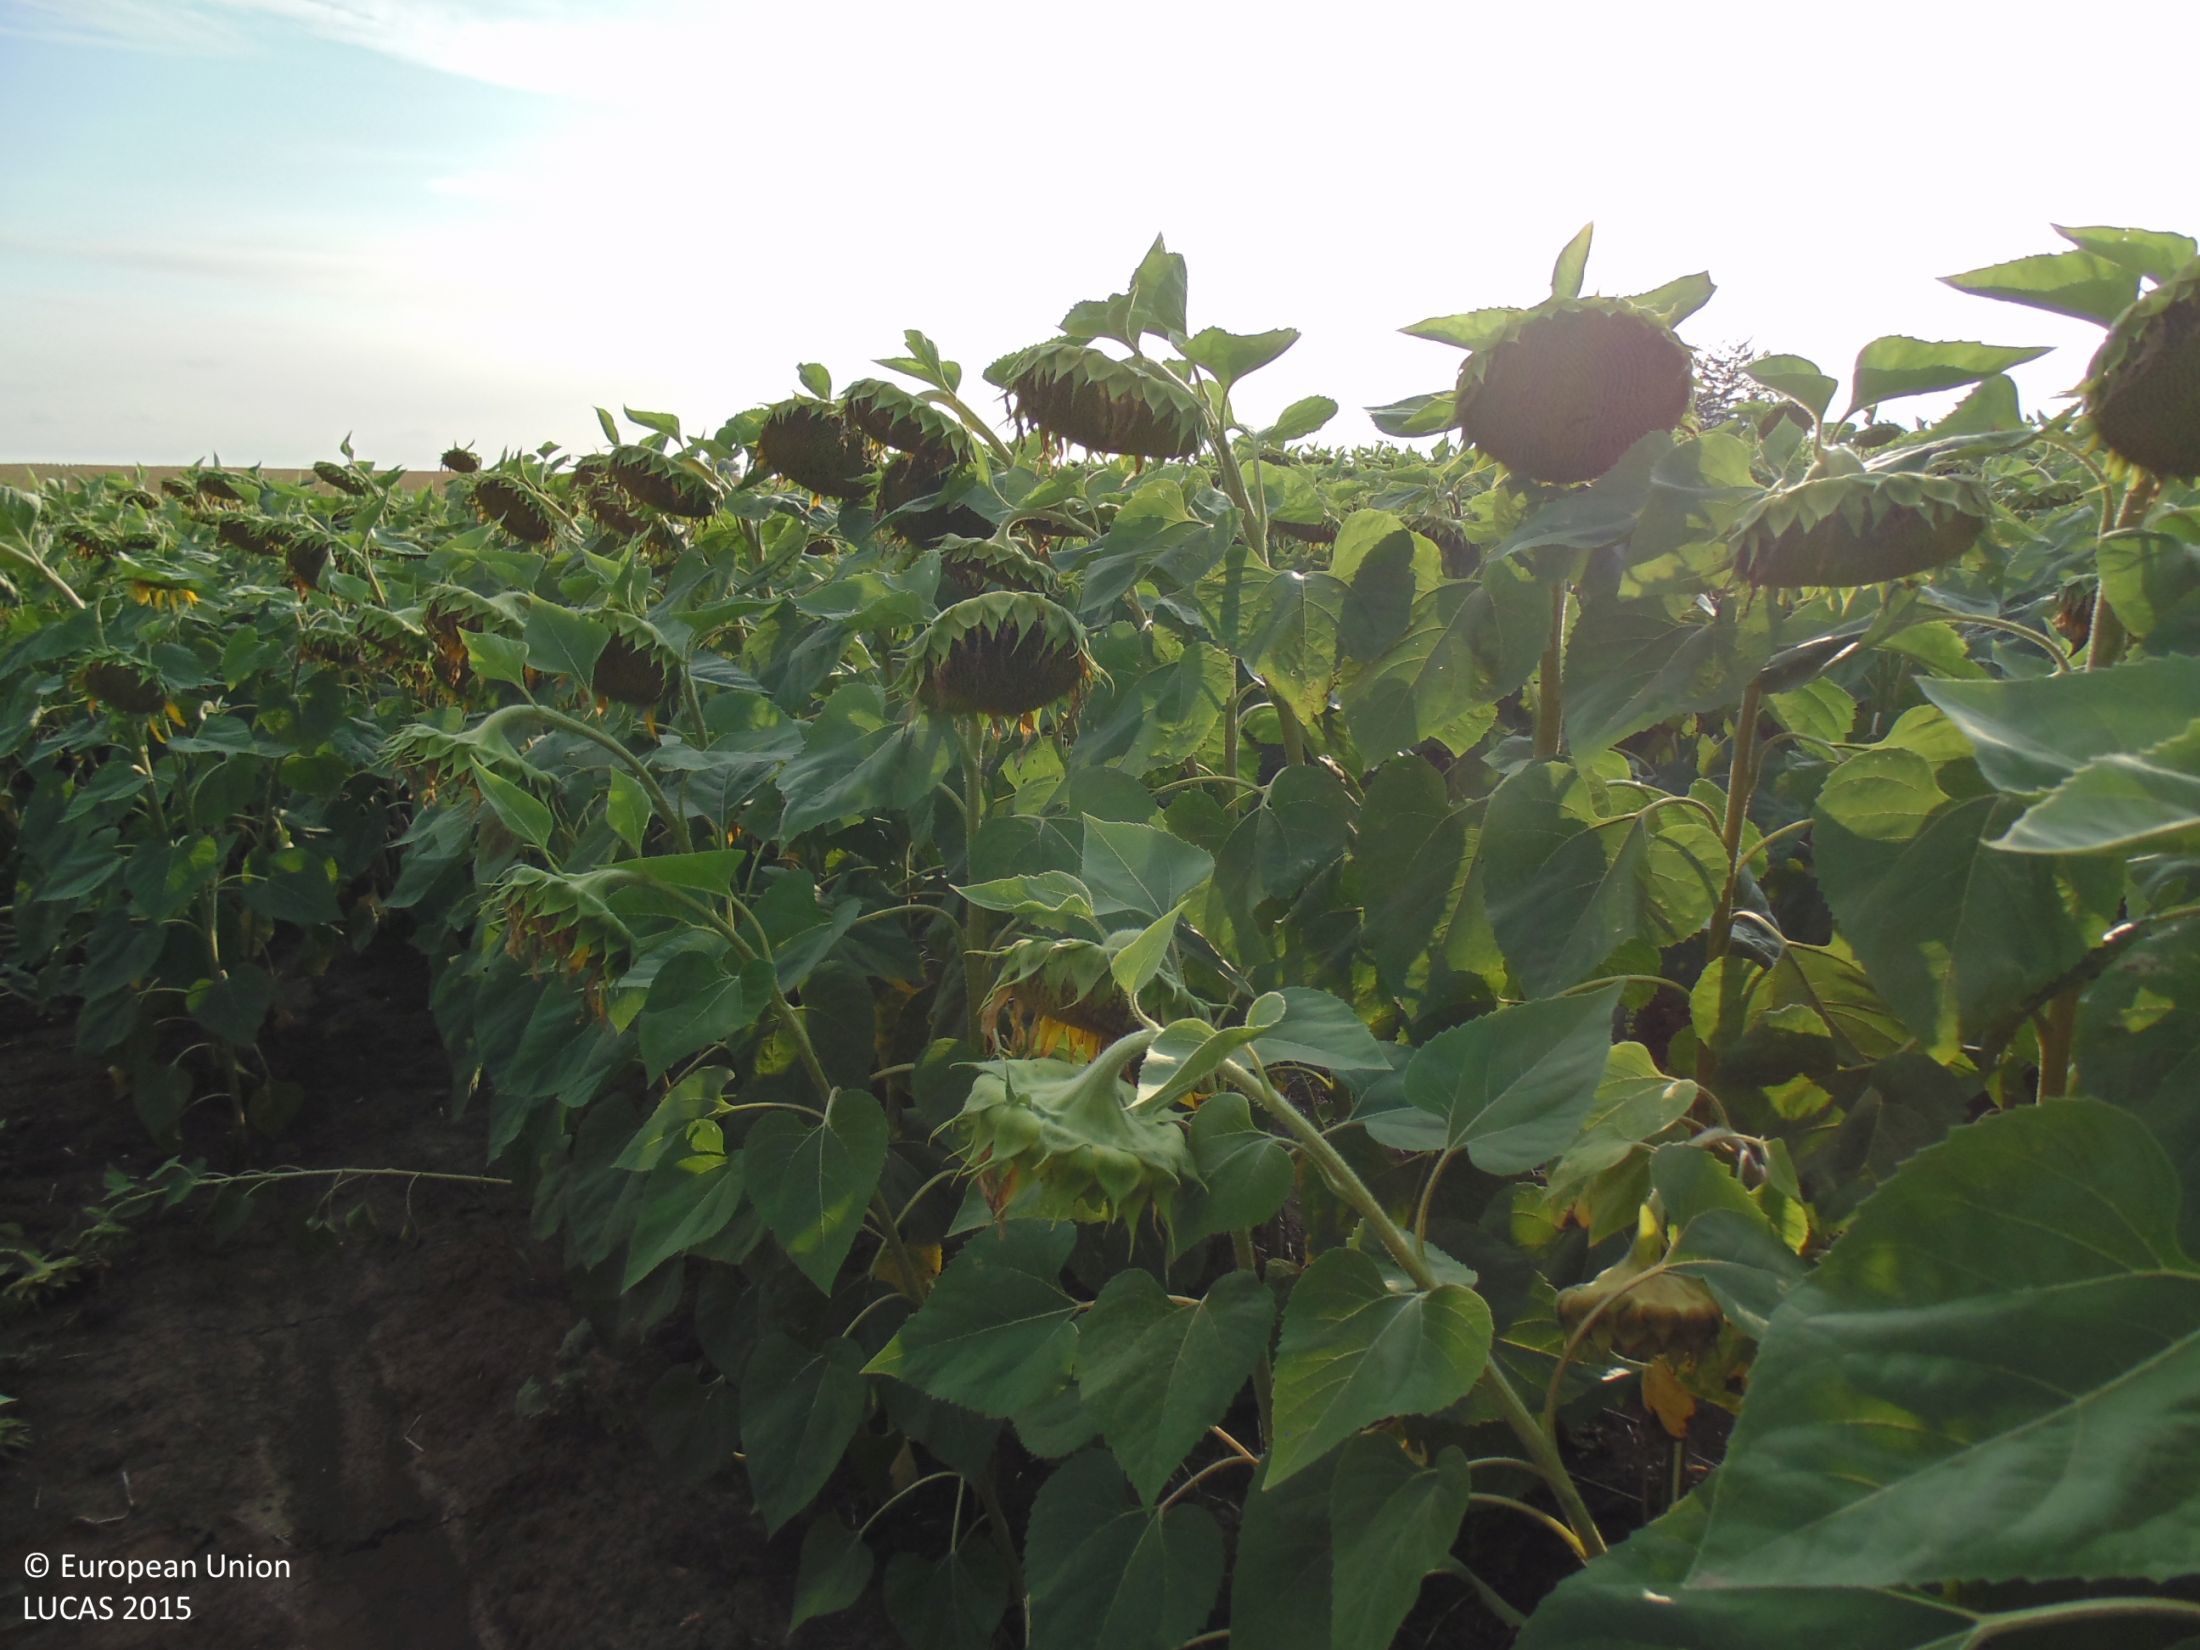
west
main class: Cropland
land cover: Sunflower
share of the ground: > 75 %
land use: Agriculture (excluding fallow land and kitchen gardens)
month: August
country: BG
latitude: 43.7617
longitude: 28.0751
